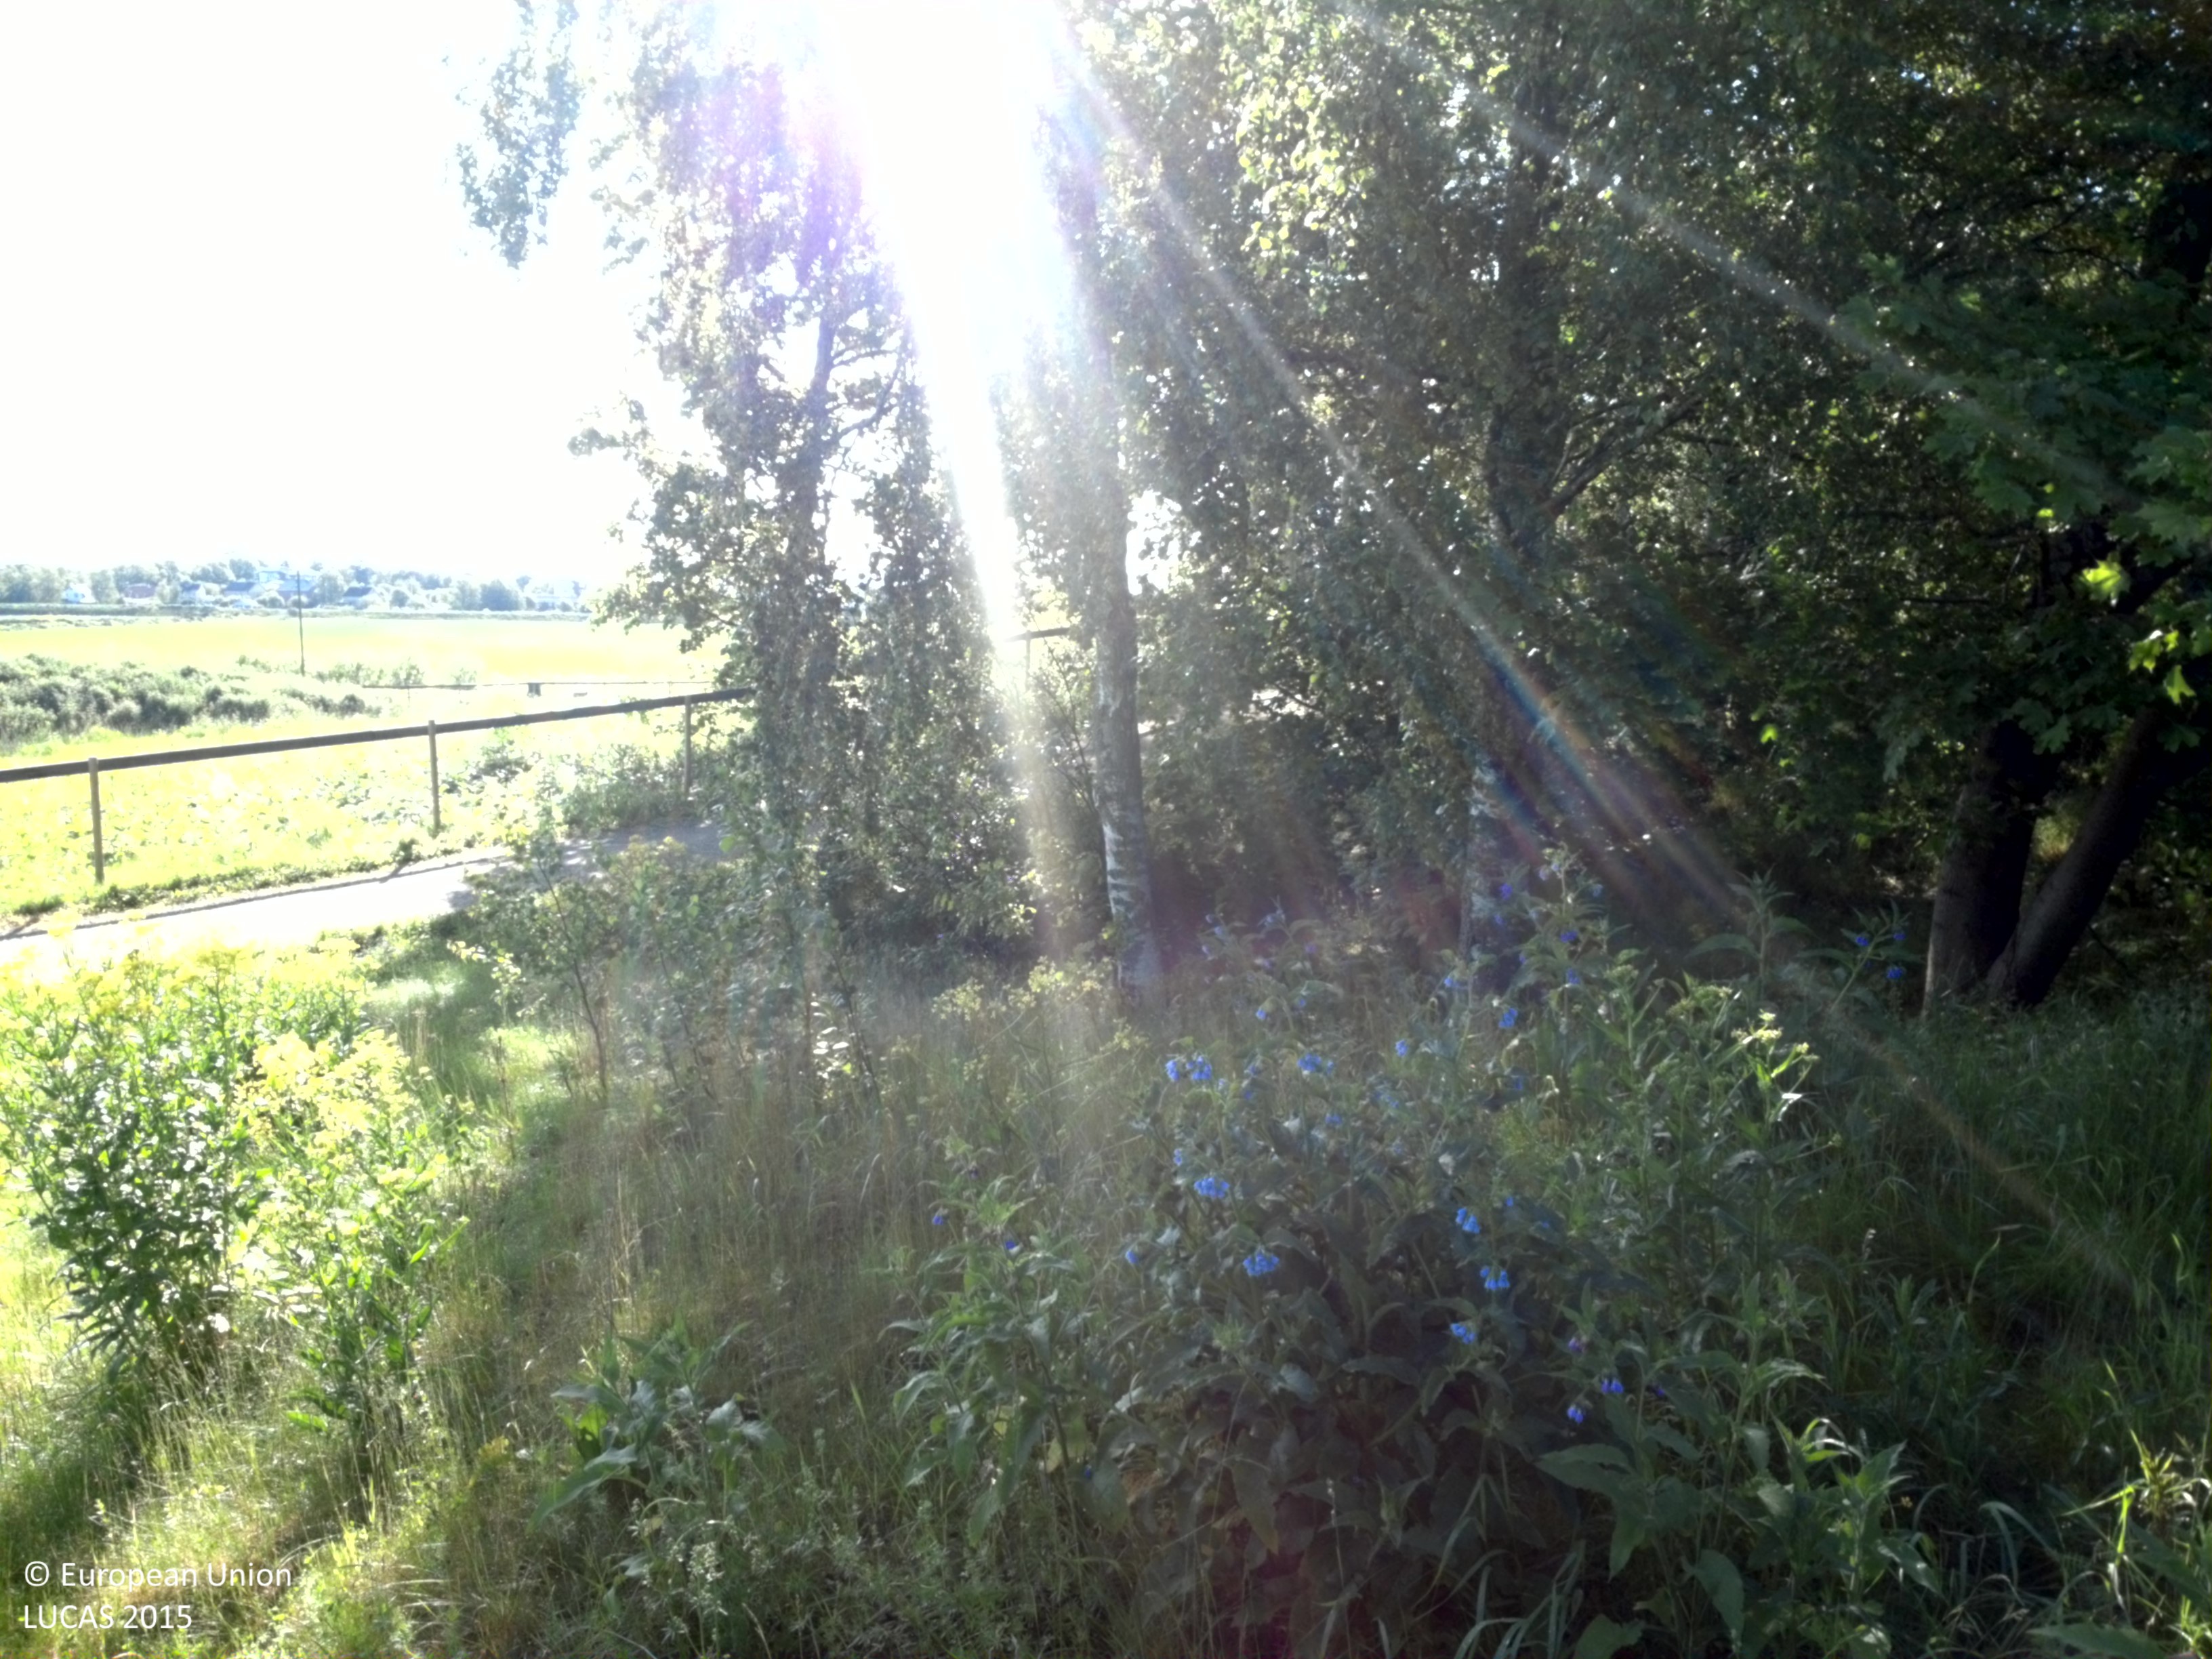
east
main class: Grassland
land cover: Grassland without tree/shrub cover
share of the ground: > 75 %
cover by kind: herbaceous plants 95 %, shrubs 5 %
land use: Semi-natural and natural areas not in use
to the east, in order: Grassland without tree/shrub cover; Broadleaved woodland; Tracks; Fences; Grassland with sparse tree/shrub cover; Fences; Grass margins; Paved roads, cycling and walking lanes; Grass margins; Paved roads, cycling and walking lanes; Grass margins; Ditches and canals; Single bushes/trees; Other leguminous and mixtures for fodder; Paved roads, cycling and walking lanes; Barley
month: June
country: SE
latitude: 59.8839
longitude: 17.6237
